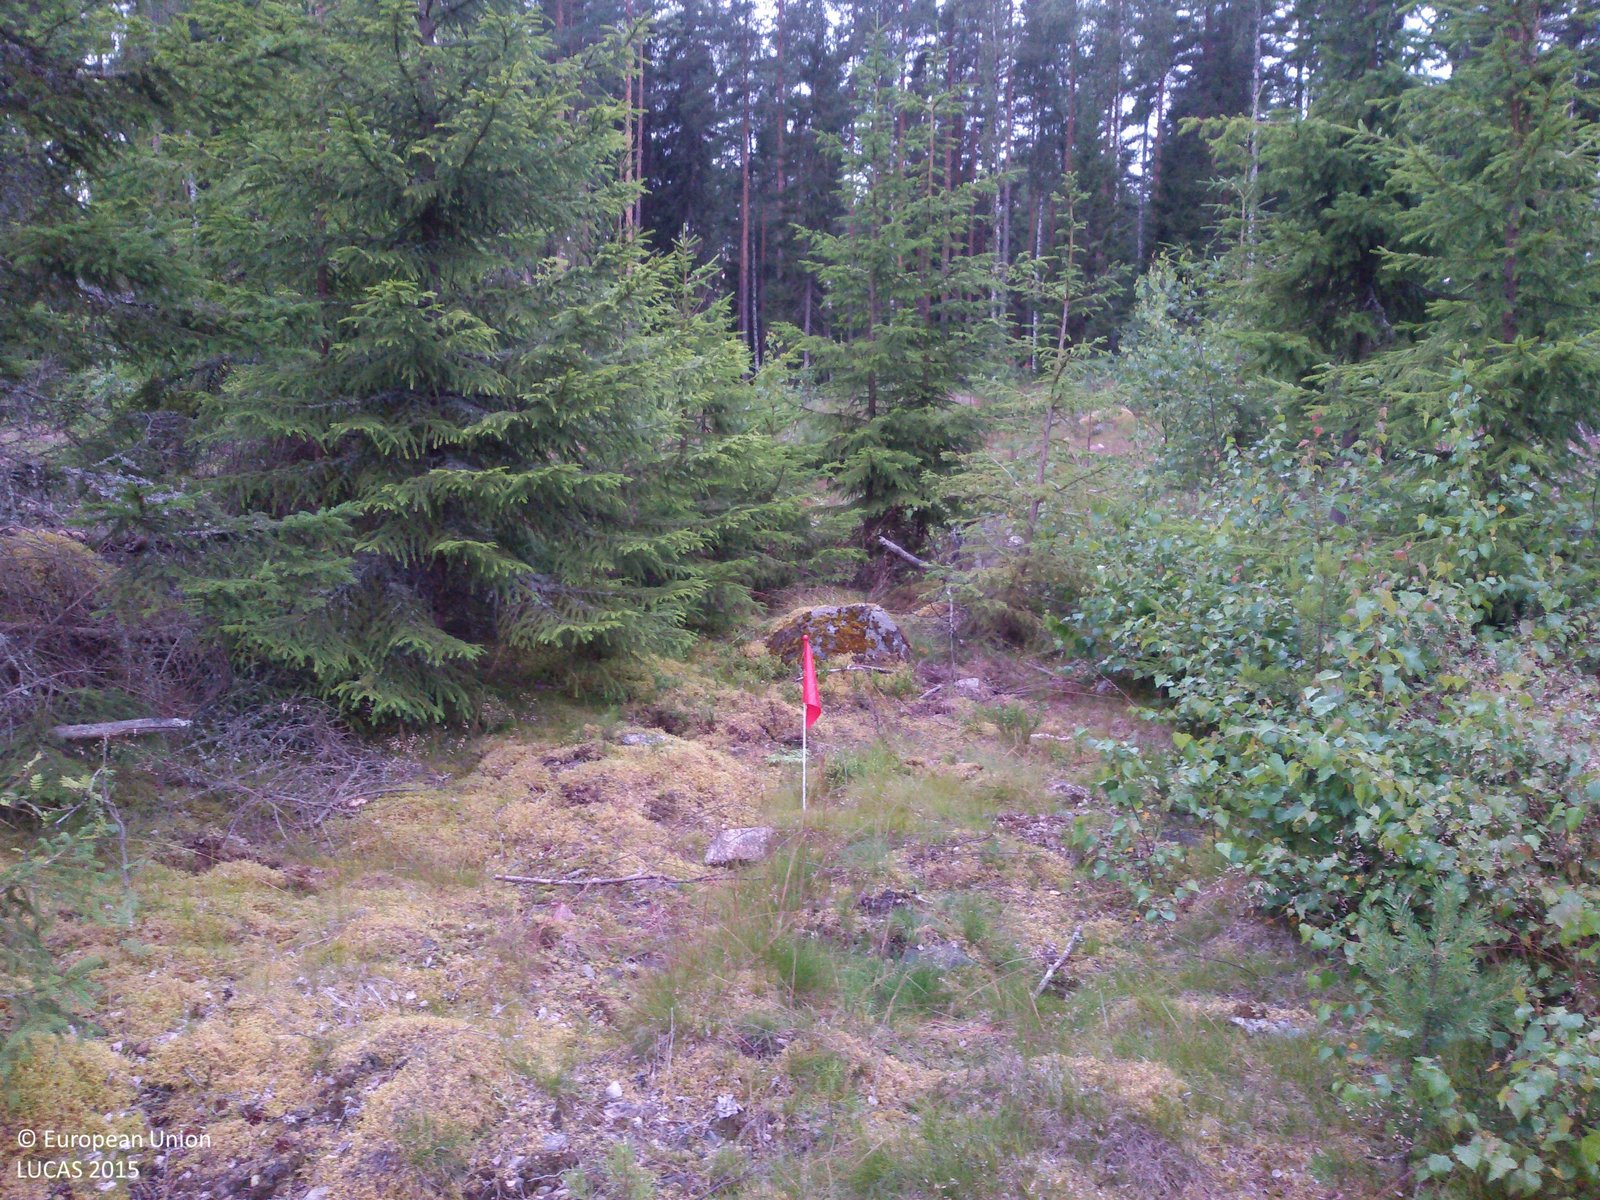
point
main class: Woodland
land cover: Spruce dominated mixed woodland
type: boreal forest
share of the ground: 50 - 75 %
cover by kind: coniferous forest trees 30 %, broadleaved forest trees 30 %, herbaceous plants 20 %, lichens and mosses 20 %
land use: Forestry
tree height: < 5 m
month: July
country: SE
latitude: 60.4383
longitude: 15.8573
